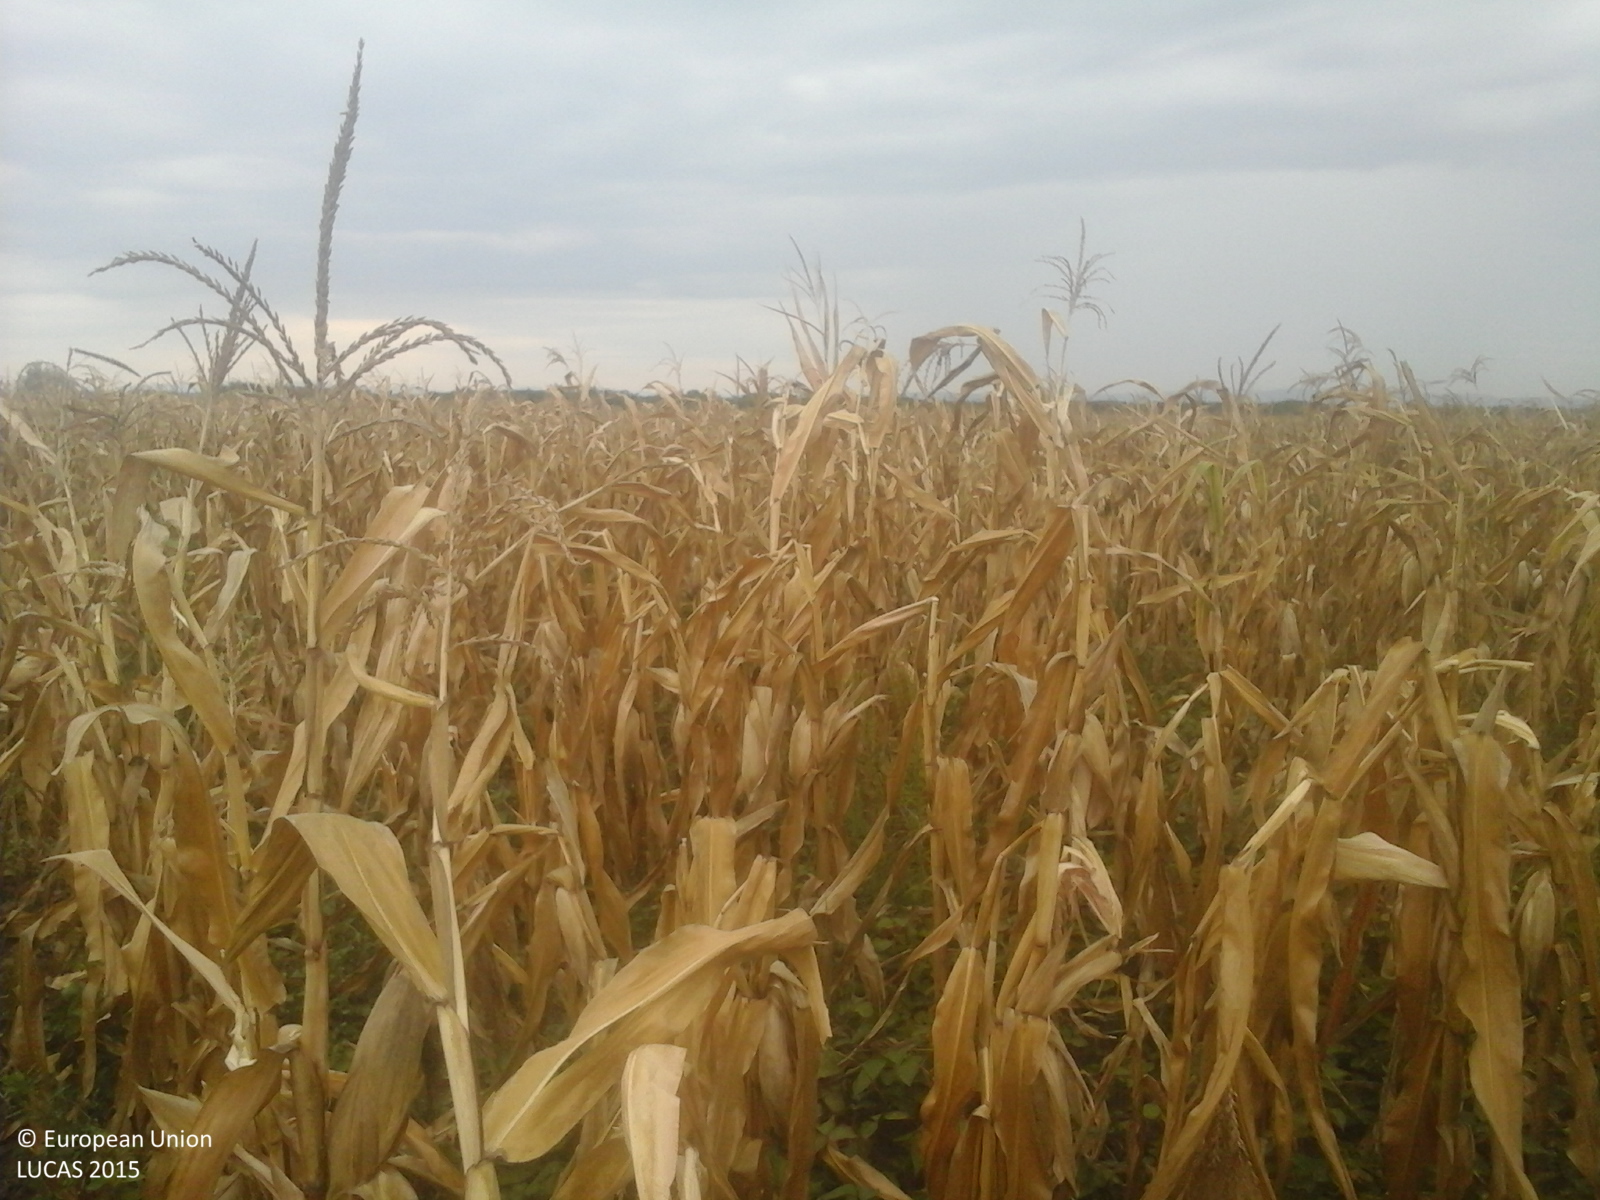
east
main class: Cropland
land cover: Maize
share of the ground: > 75 %
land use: Agriculture (excluding fallow land and kitchen gardens)
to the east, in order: Maize; Soya
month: September
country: RO
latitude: 47.6323
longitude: 22.6905
